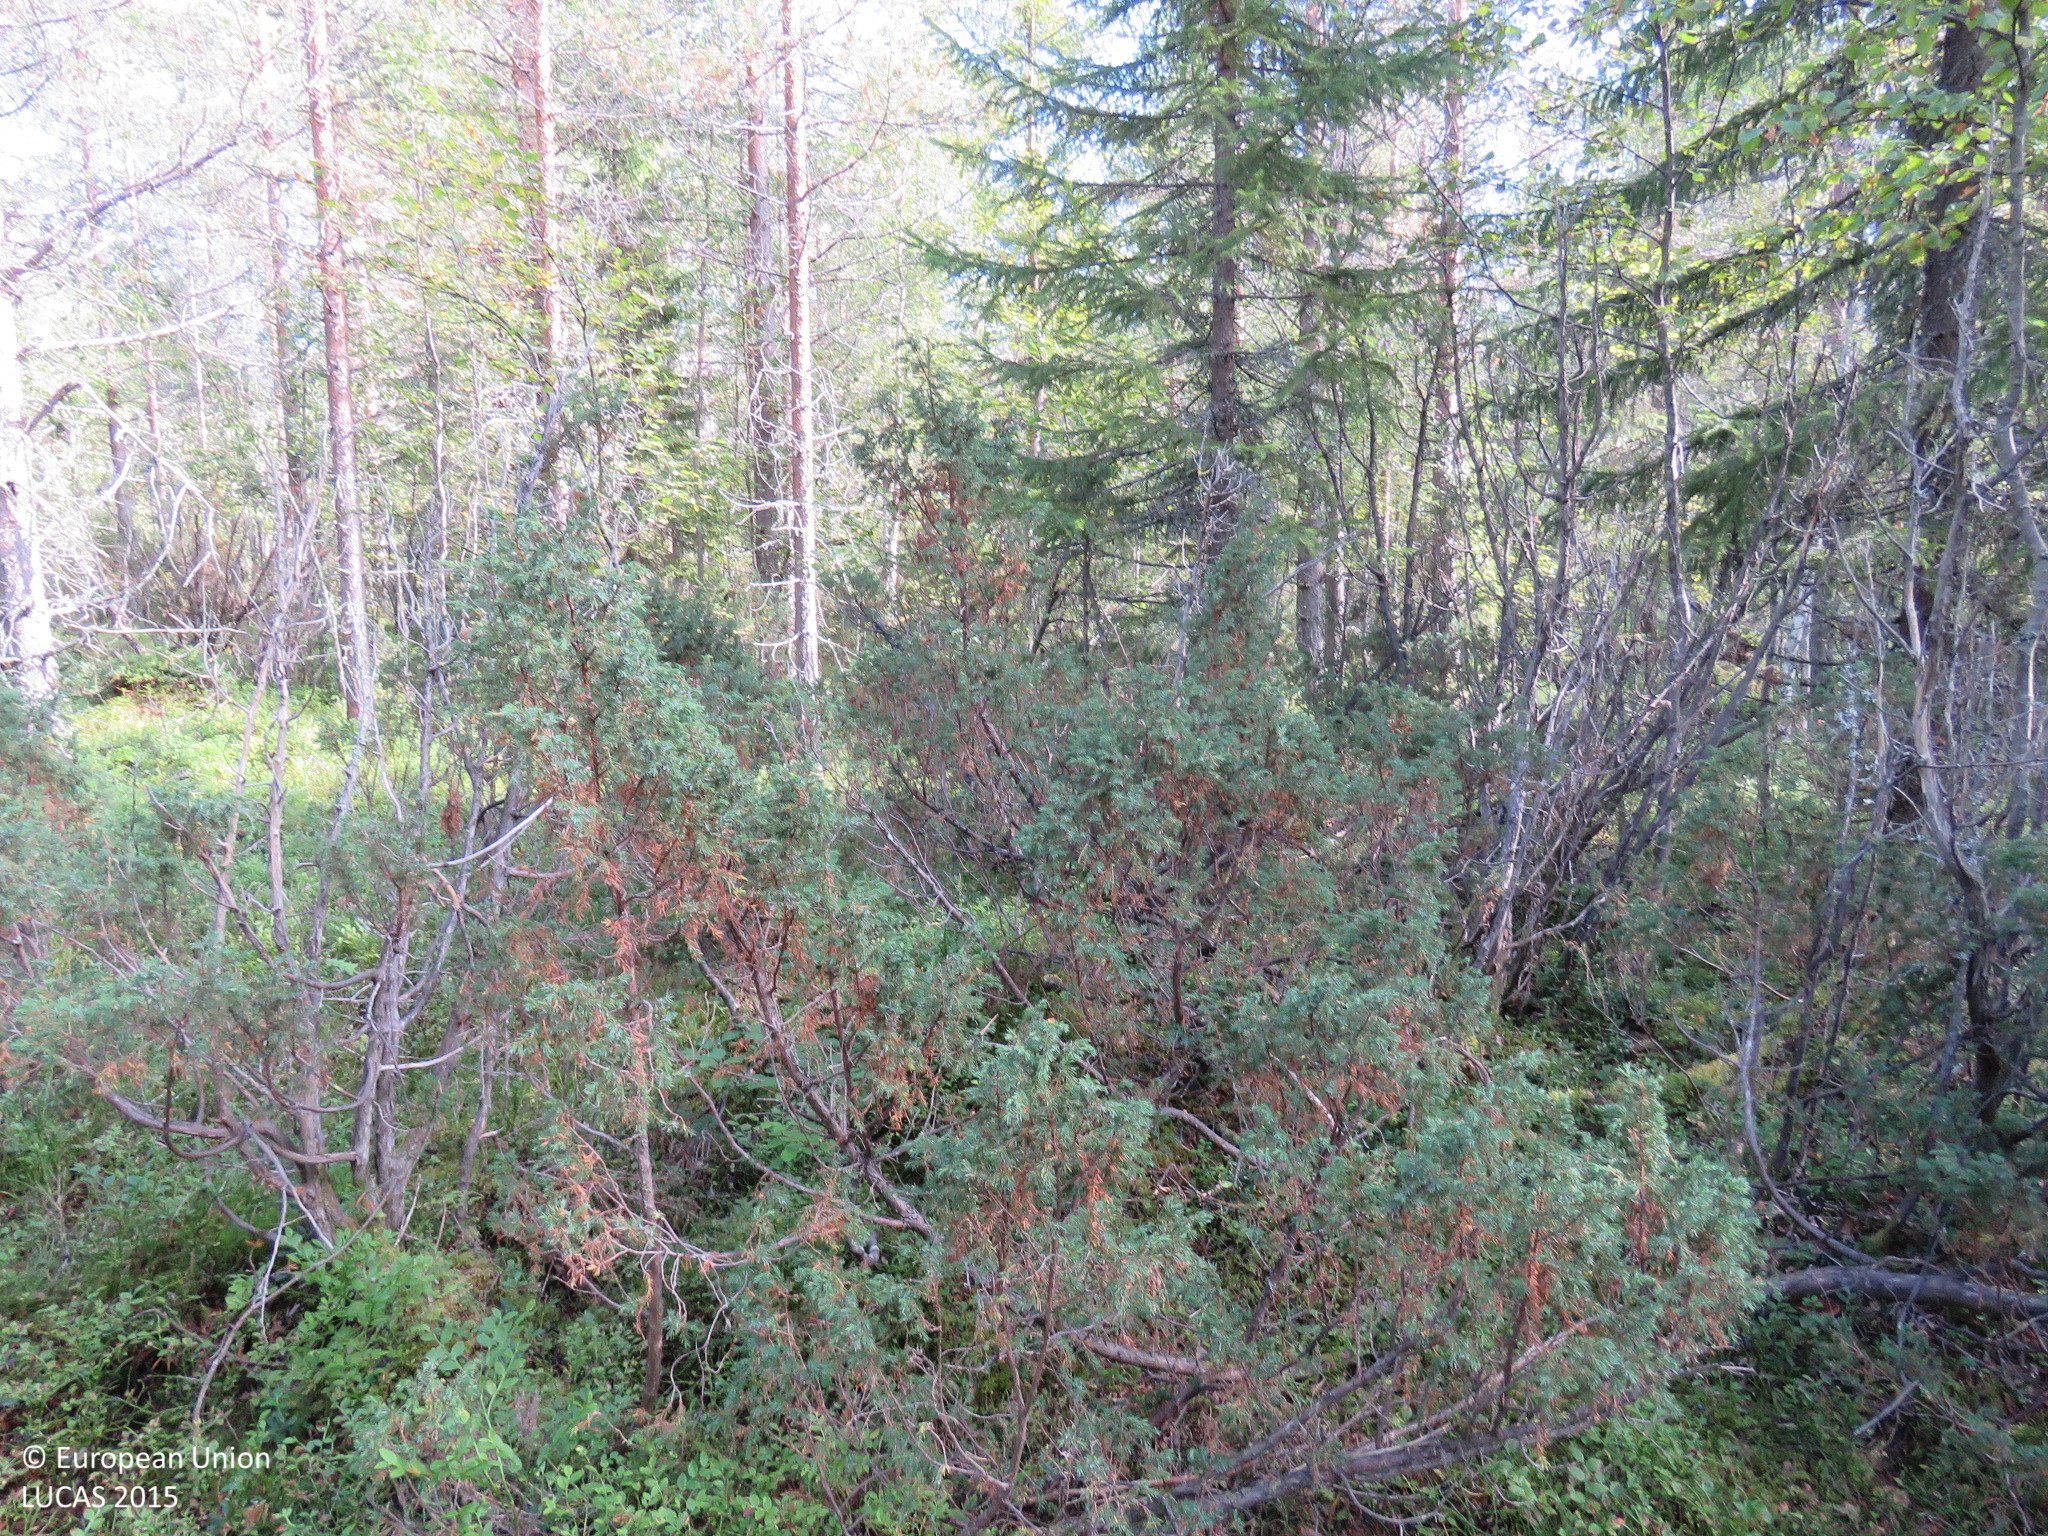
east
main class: Woodland
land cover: Other mixed woodland
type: boreal forest
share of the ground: > 75 %
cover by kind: coniferous forest trees 50 %, broadleaved forest trees 25 %, shrubs 20 %, lichens and mosses 5 %
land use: Forestry
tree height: > 5 m
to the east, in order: Other mixed woodland; Other coniferous woodland; Spruce dominated coniferous woodland
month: September
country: FI
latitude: 65.4088
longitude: 27.6439
